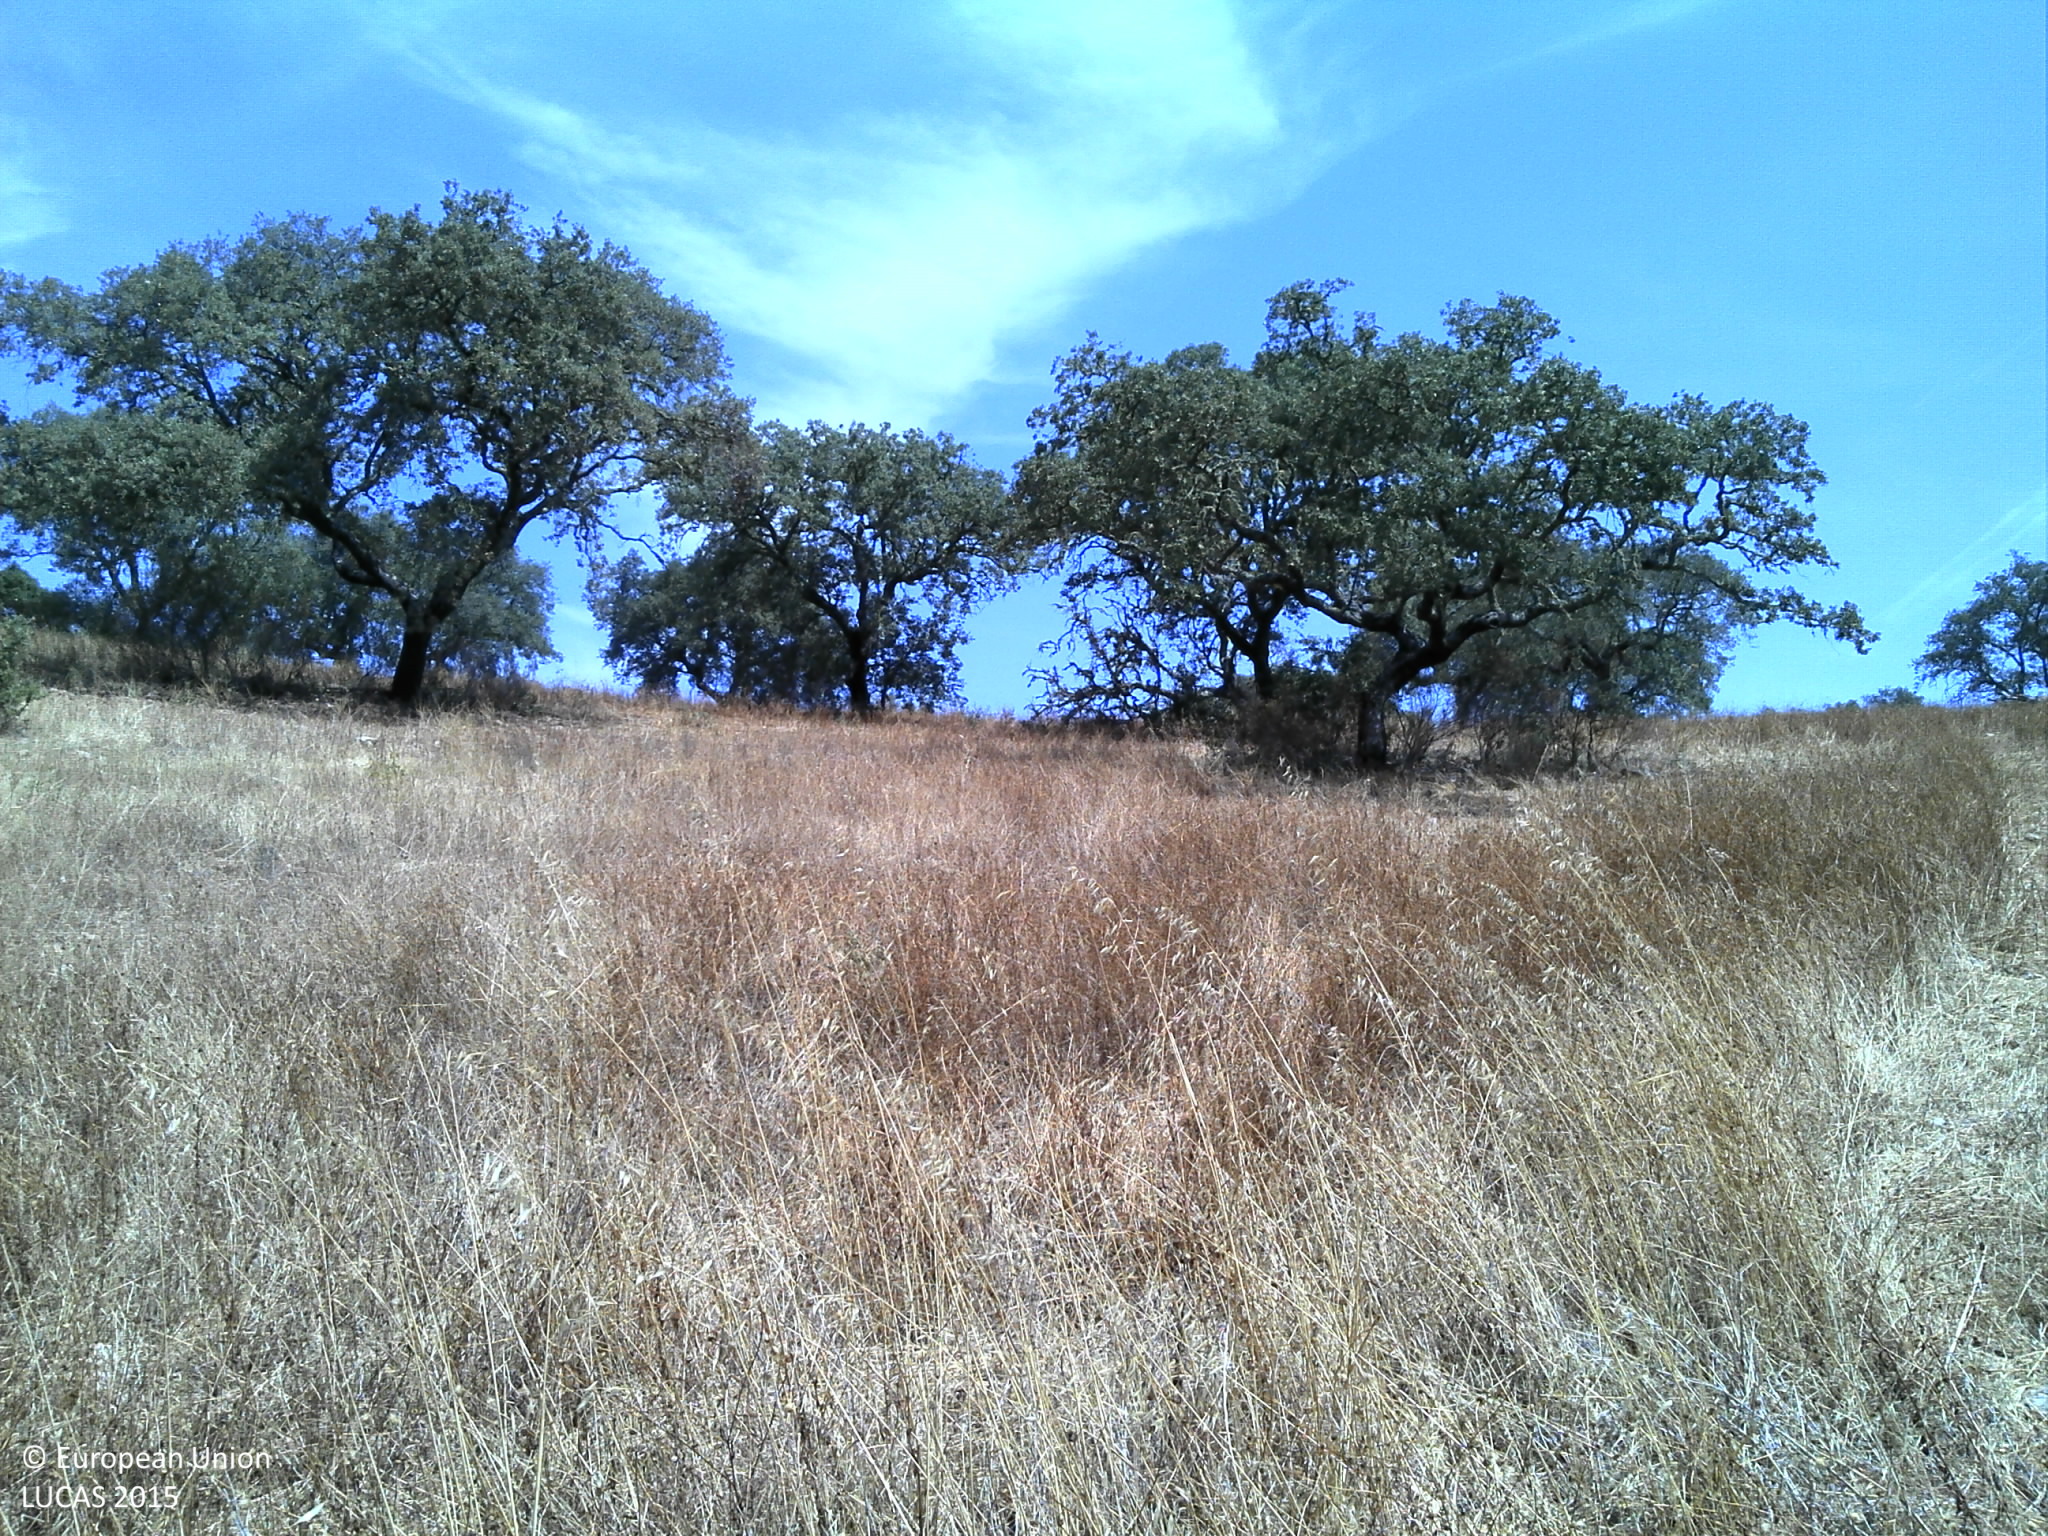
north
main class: Grassland
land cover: Grassland without tree/shrub cover
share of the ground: 25 - 50 %
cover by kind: unconsolidated bare surface 65 %, herbaceous plants 30 %, shrubs 5 %
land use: Agriculture (excluding fallow land and kitchen gardens)
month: July
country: PT
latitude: 38.5171
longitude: -7.6841
